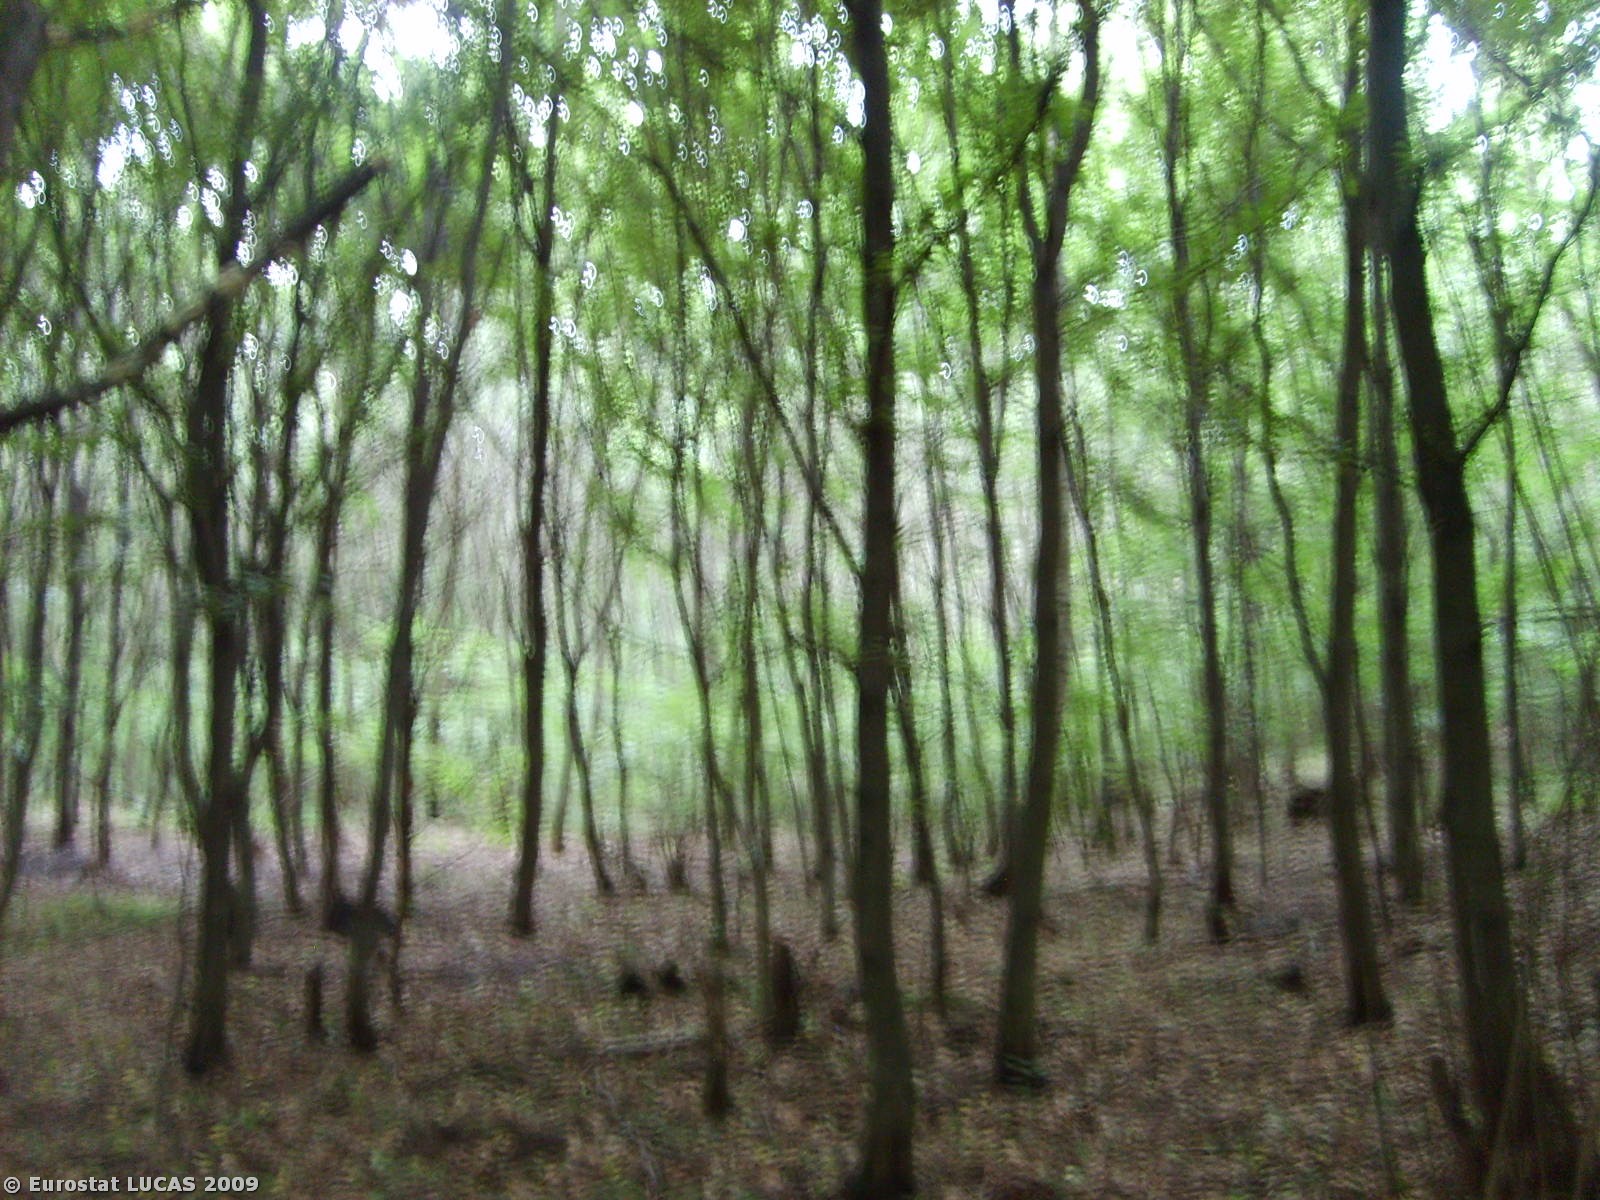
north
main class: Woodland
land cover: Broadleaved woodland
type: mesophytic deciduous forest
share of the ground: > 75 %
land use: Forestry
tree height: > 5 m
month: June
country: PL
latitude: 50.4315
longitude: 20.4124
